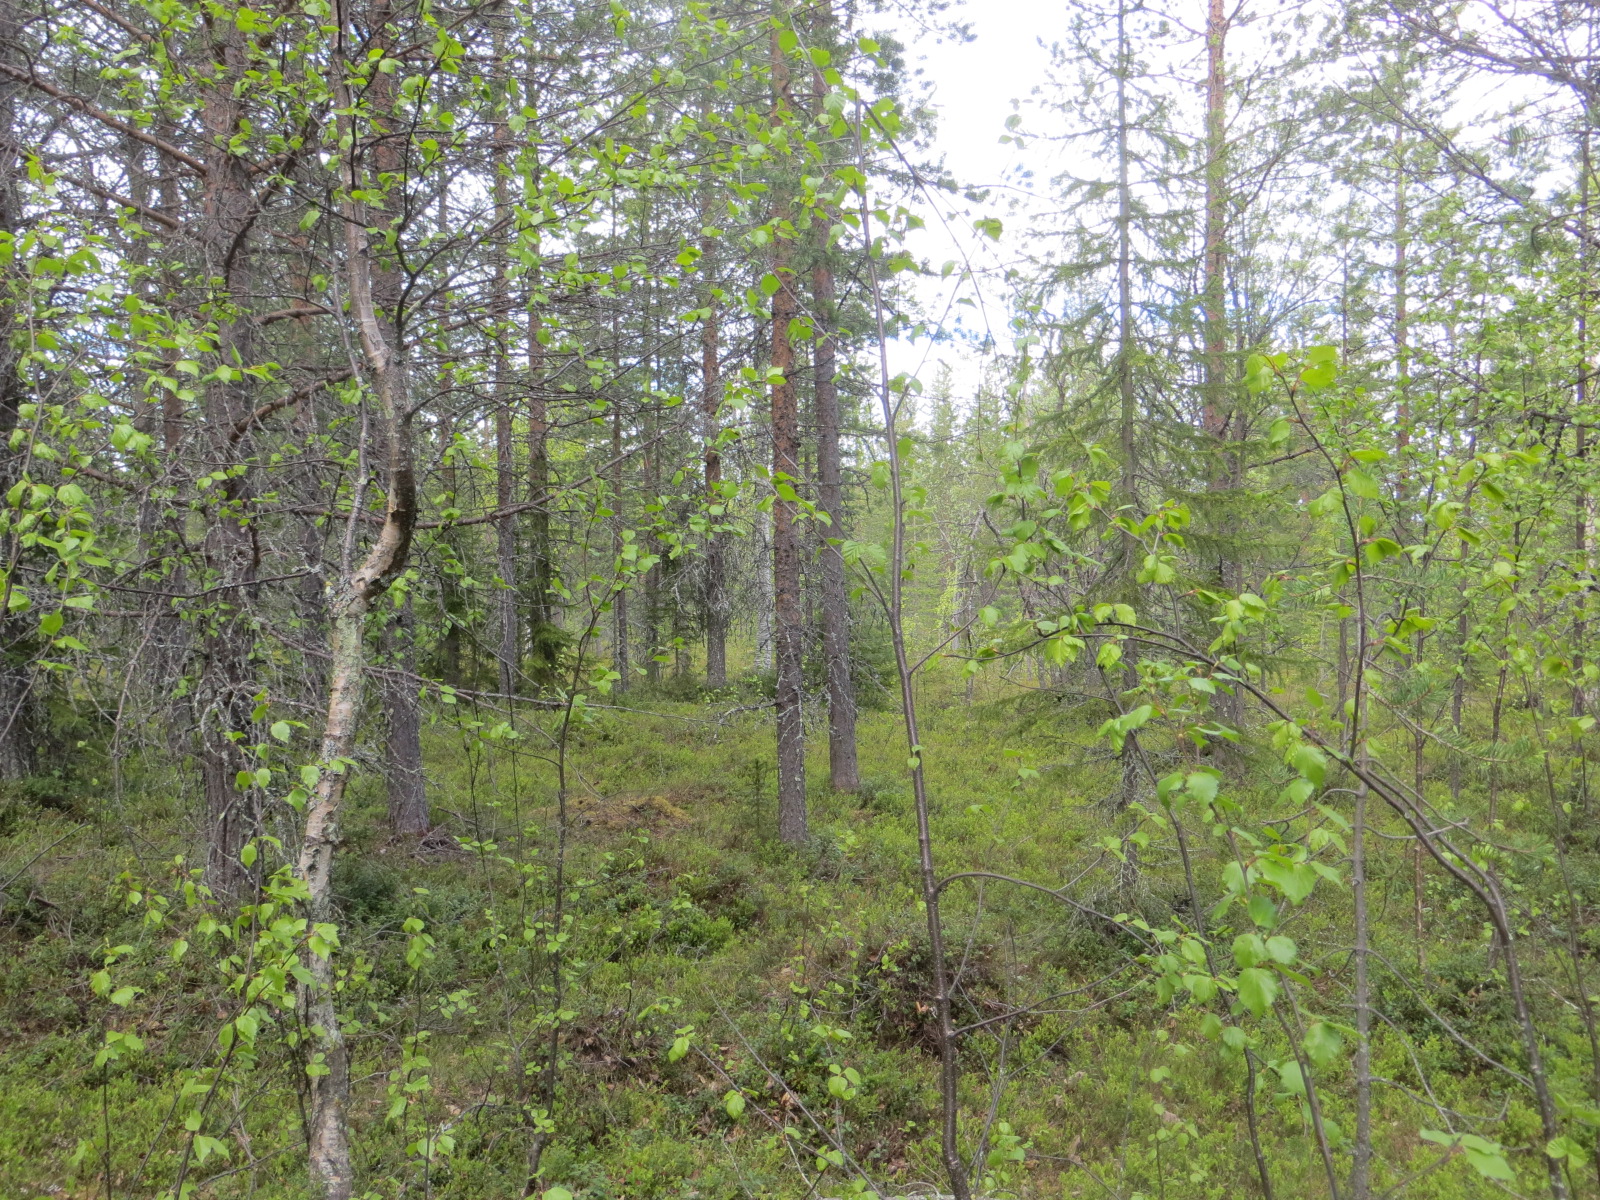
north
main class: Woodland
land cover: Pine dominated coniferous woodland
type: boreal forest
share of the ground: > 75 %
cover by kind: coniferous forest trees 70 %, broadleaved forest trees 15 %, shrubs 10 %, lichens and mosses 5 %
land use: Forestry
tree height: > 5 m
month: June
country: FI
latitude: 67.2930
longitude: 26.1539
